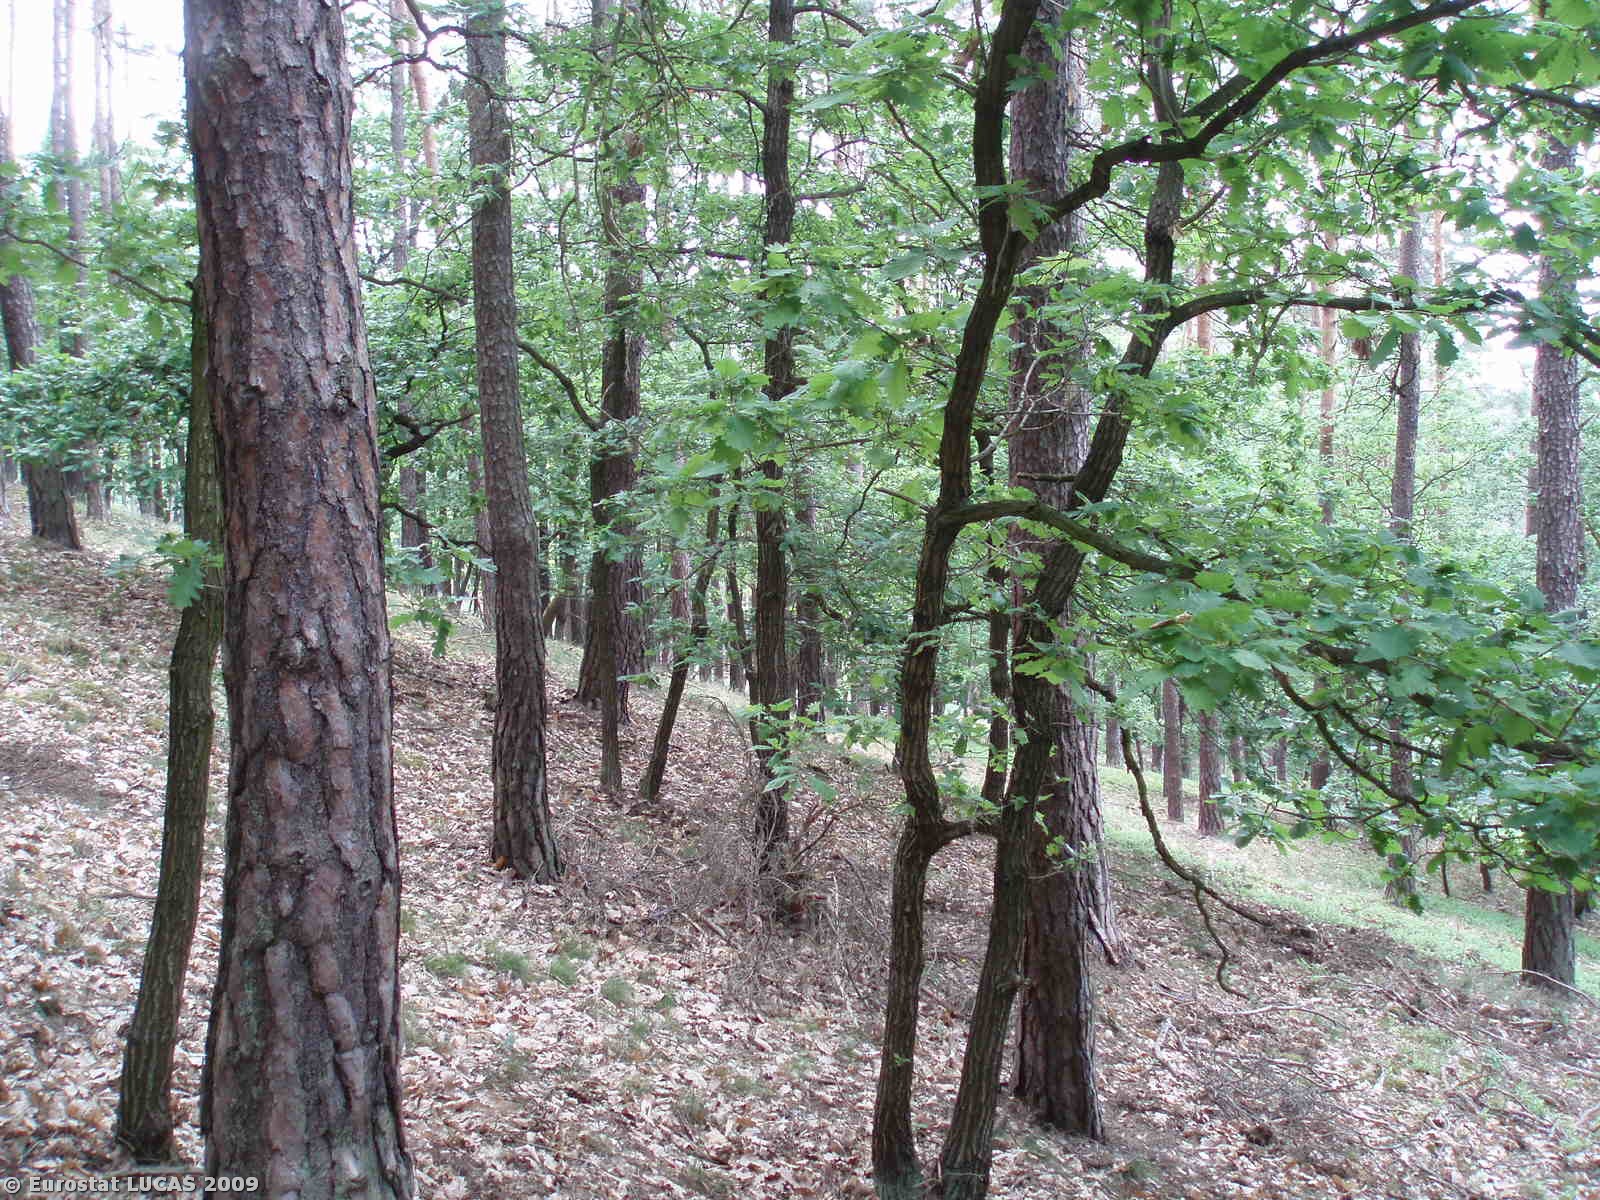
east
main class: Woodland
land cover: Mixed woodland
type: hemiboreal forest and nemoral coniferous forest and mixed broadleaved-coniferous forest
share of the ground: > 75 %
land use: Forestry
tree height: > 5 m
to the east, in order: Mixed woodland; Tracks; Mixed woodland
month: May
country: CZ
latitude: 50.0199
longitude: 14.1183
